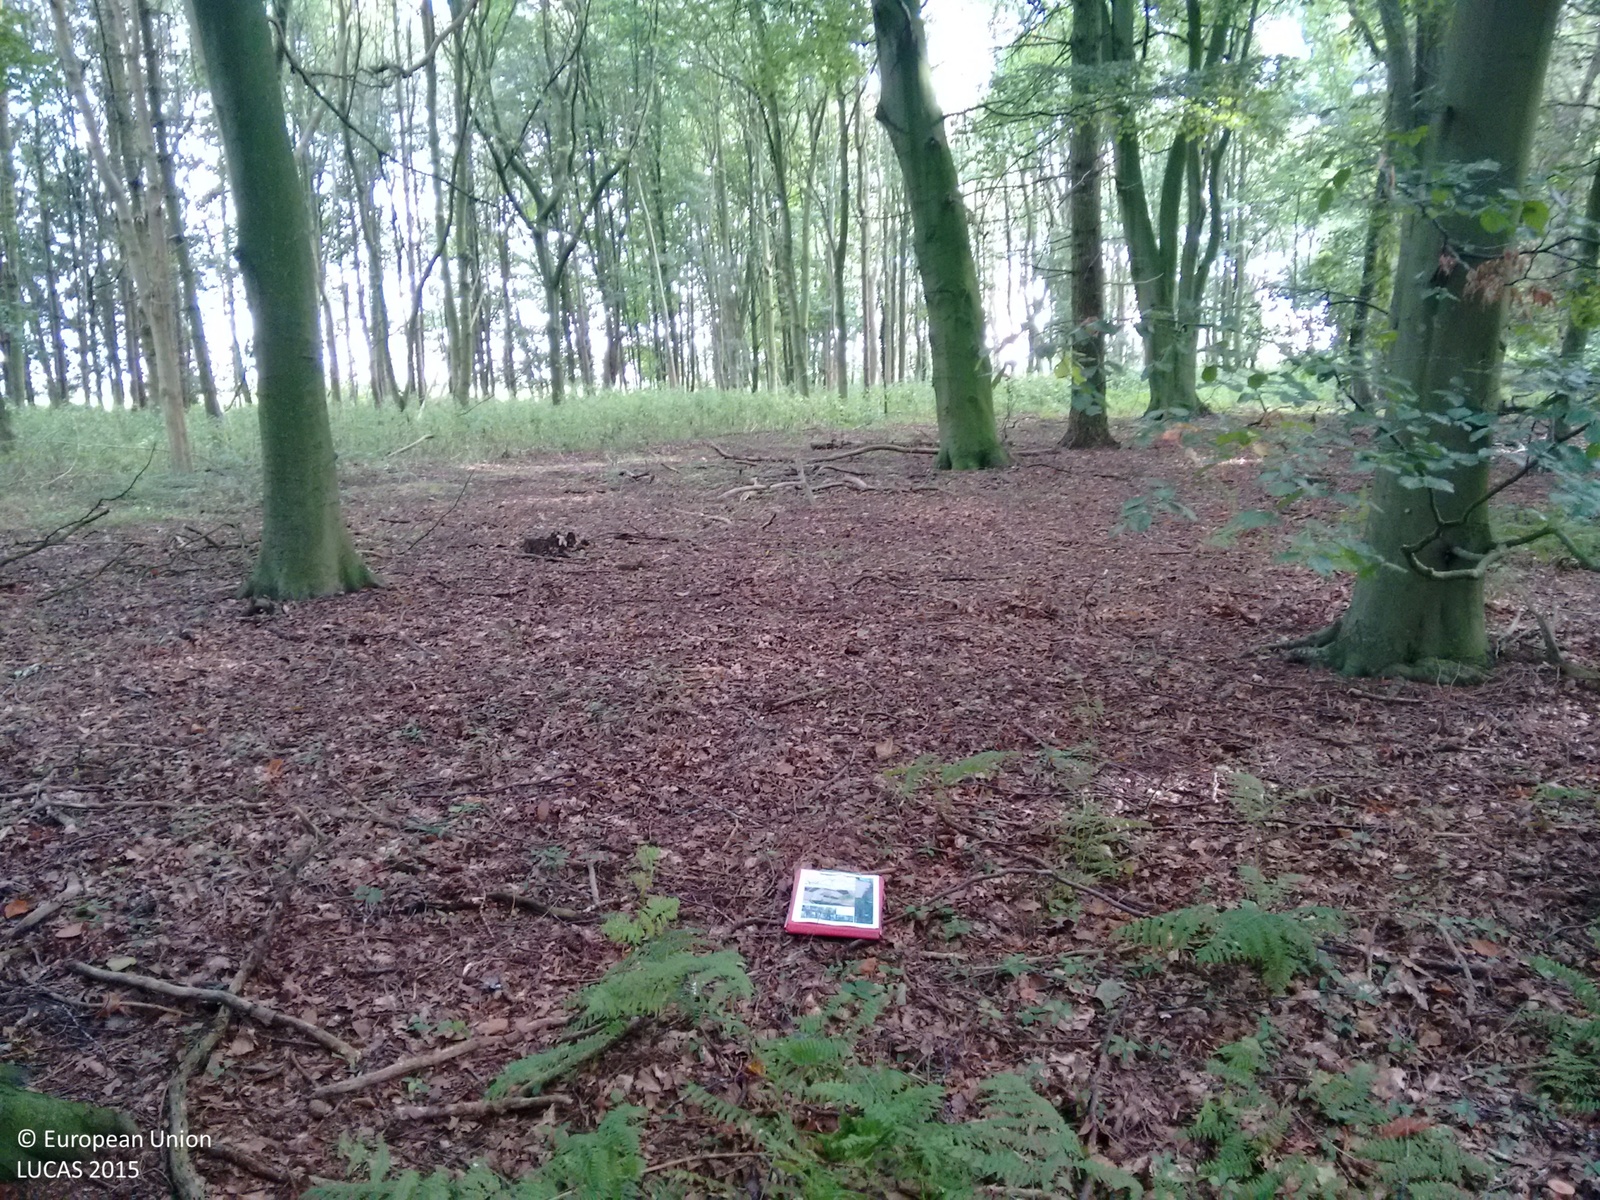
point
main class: Woodland
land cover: Other mixed woodland
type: mesophytic deciduous forest
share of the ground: > 75 %
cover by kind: broadleaved forest trees 75 %, coniferous forest trees 25 %
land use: Agriculture (excluding fallow land and kitchen gardens)
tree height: > 5 m
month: September
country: GB
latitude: 52.4412
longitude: 0.8696
